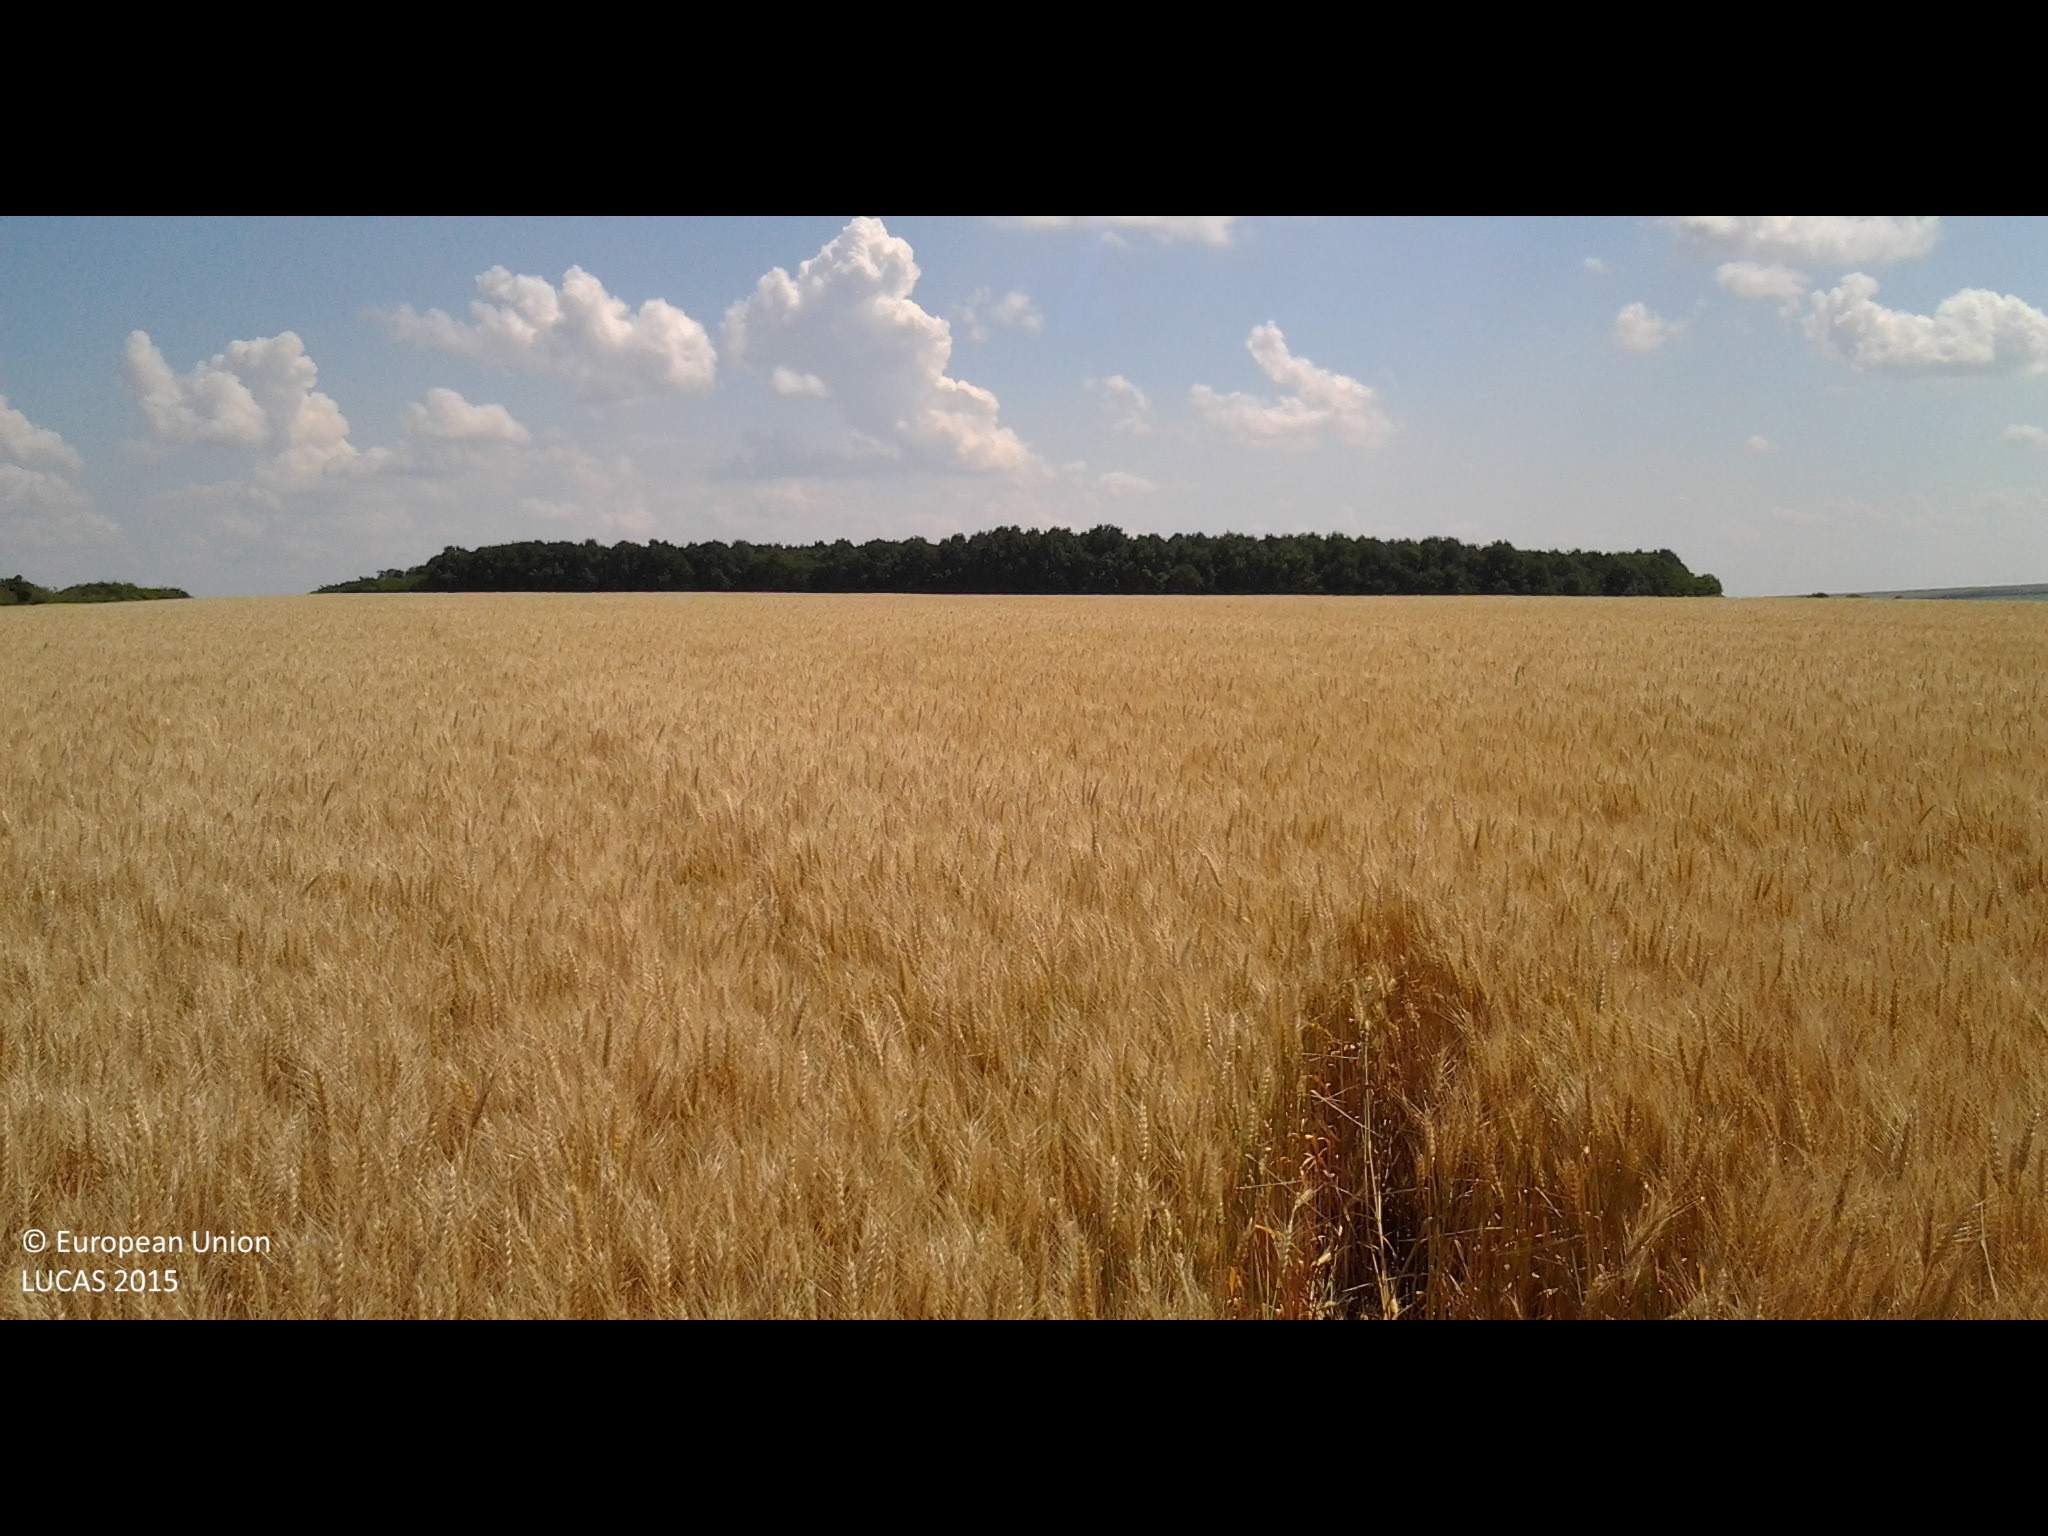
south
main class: Cropland
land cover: Common wheat
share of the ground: > 75 %
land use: Agriculture (excluding fallow land and kitchen gardens)
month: June
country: RO
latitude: 47.5582
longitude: 27.0770
